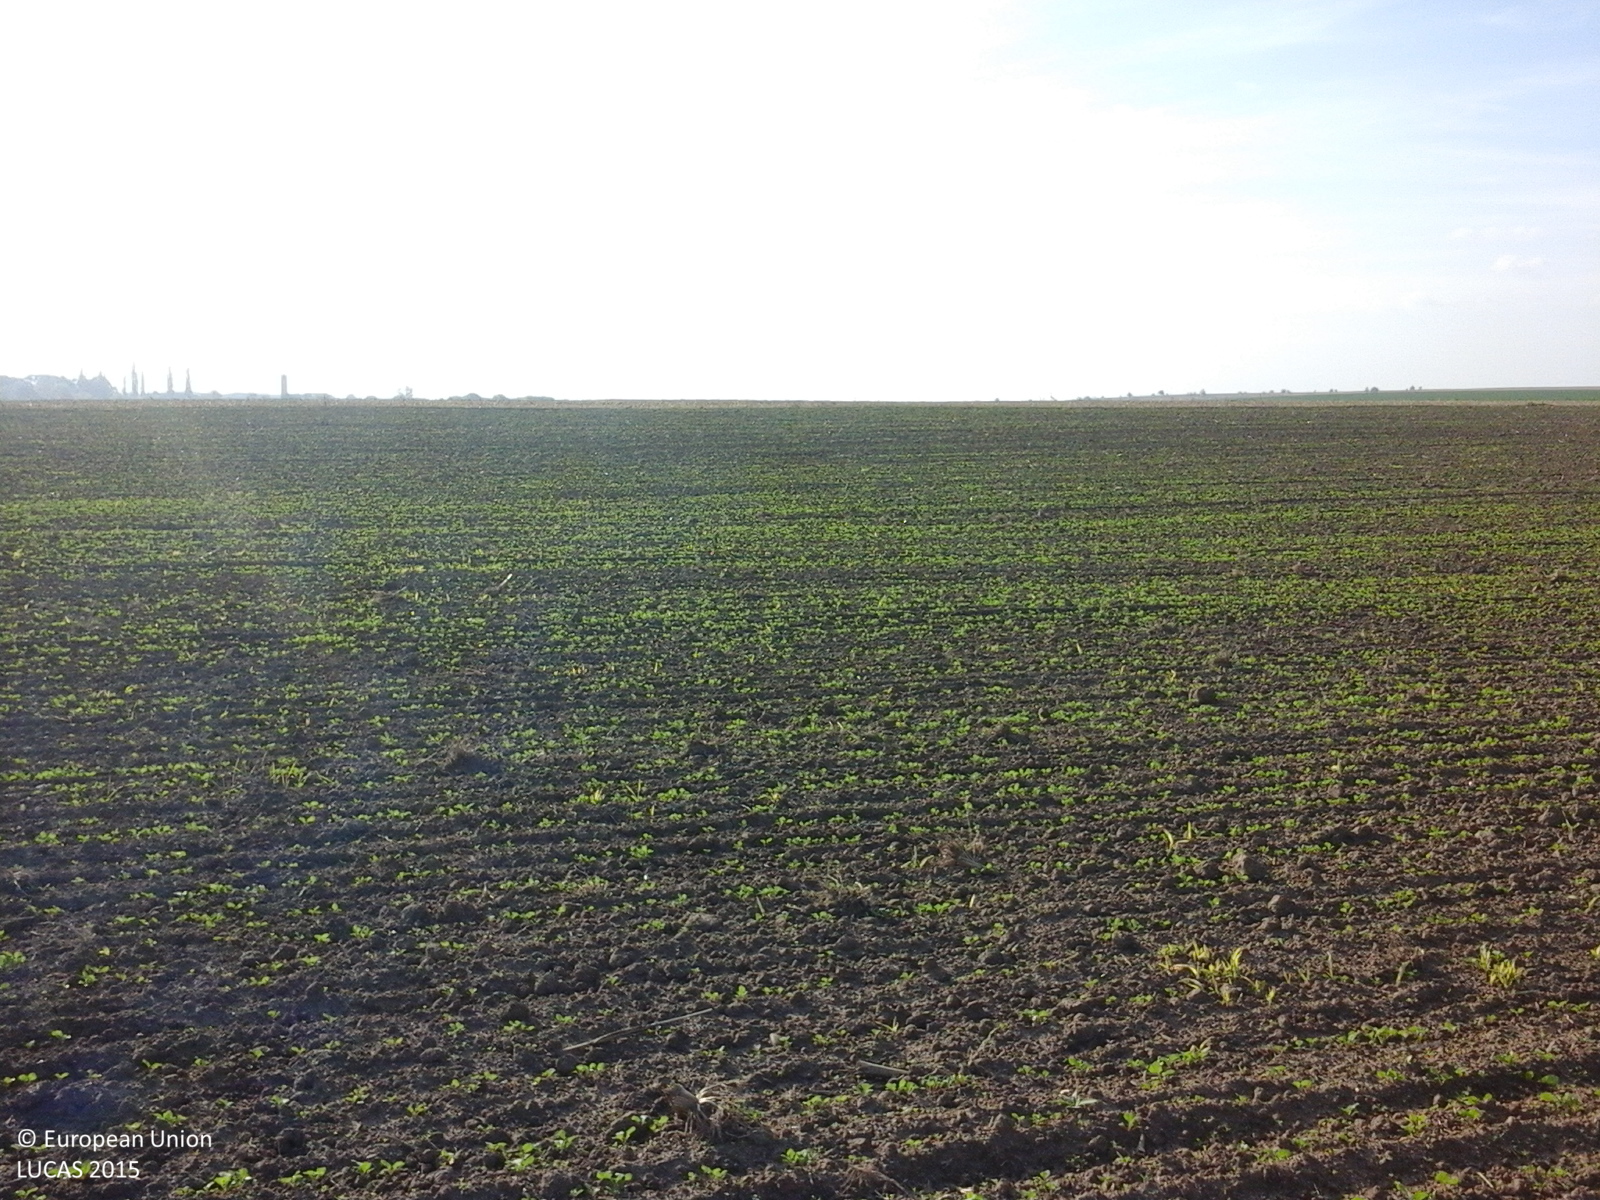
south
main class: Cropland
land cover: Rape and turnip rape
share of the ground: < 10 %
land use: Agriculture (excluding fallow land and kitchen gardens)
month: October
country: RO
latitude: 46.0141
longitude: 27.1849
